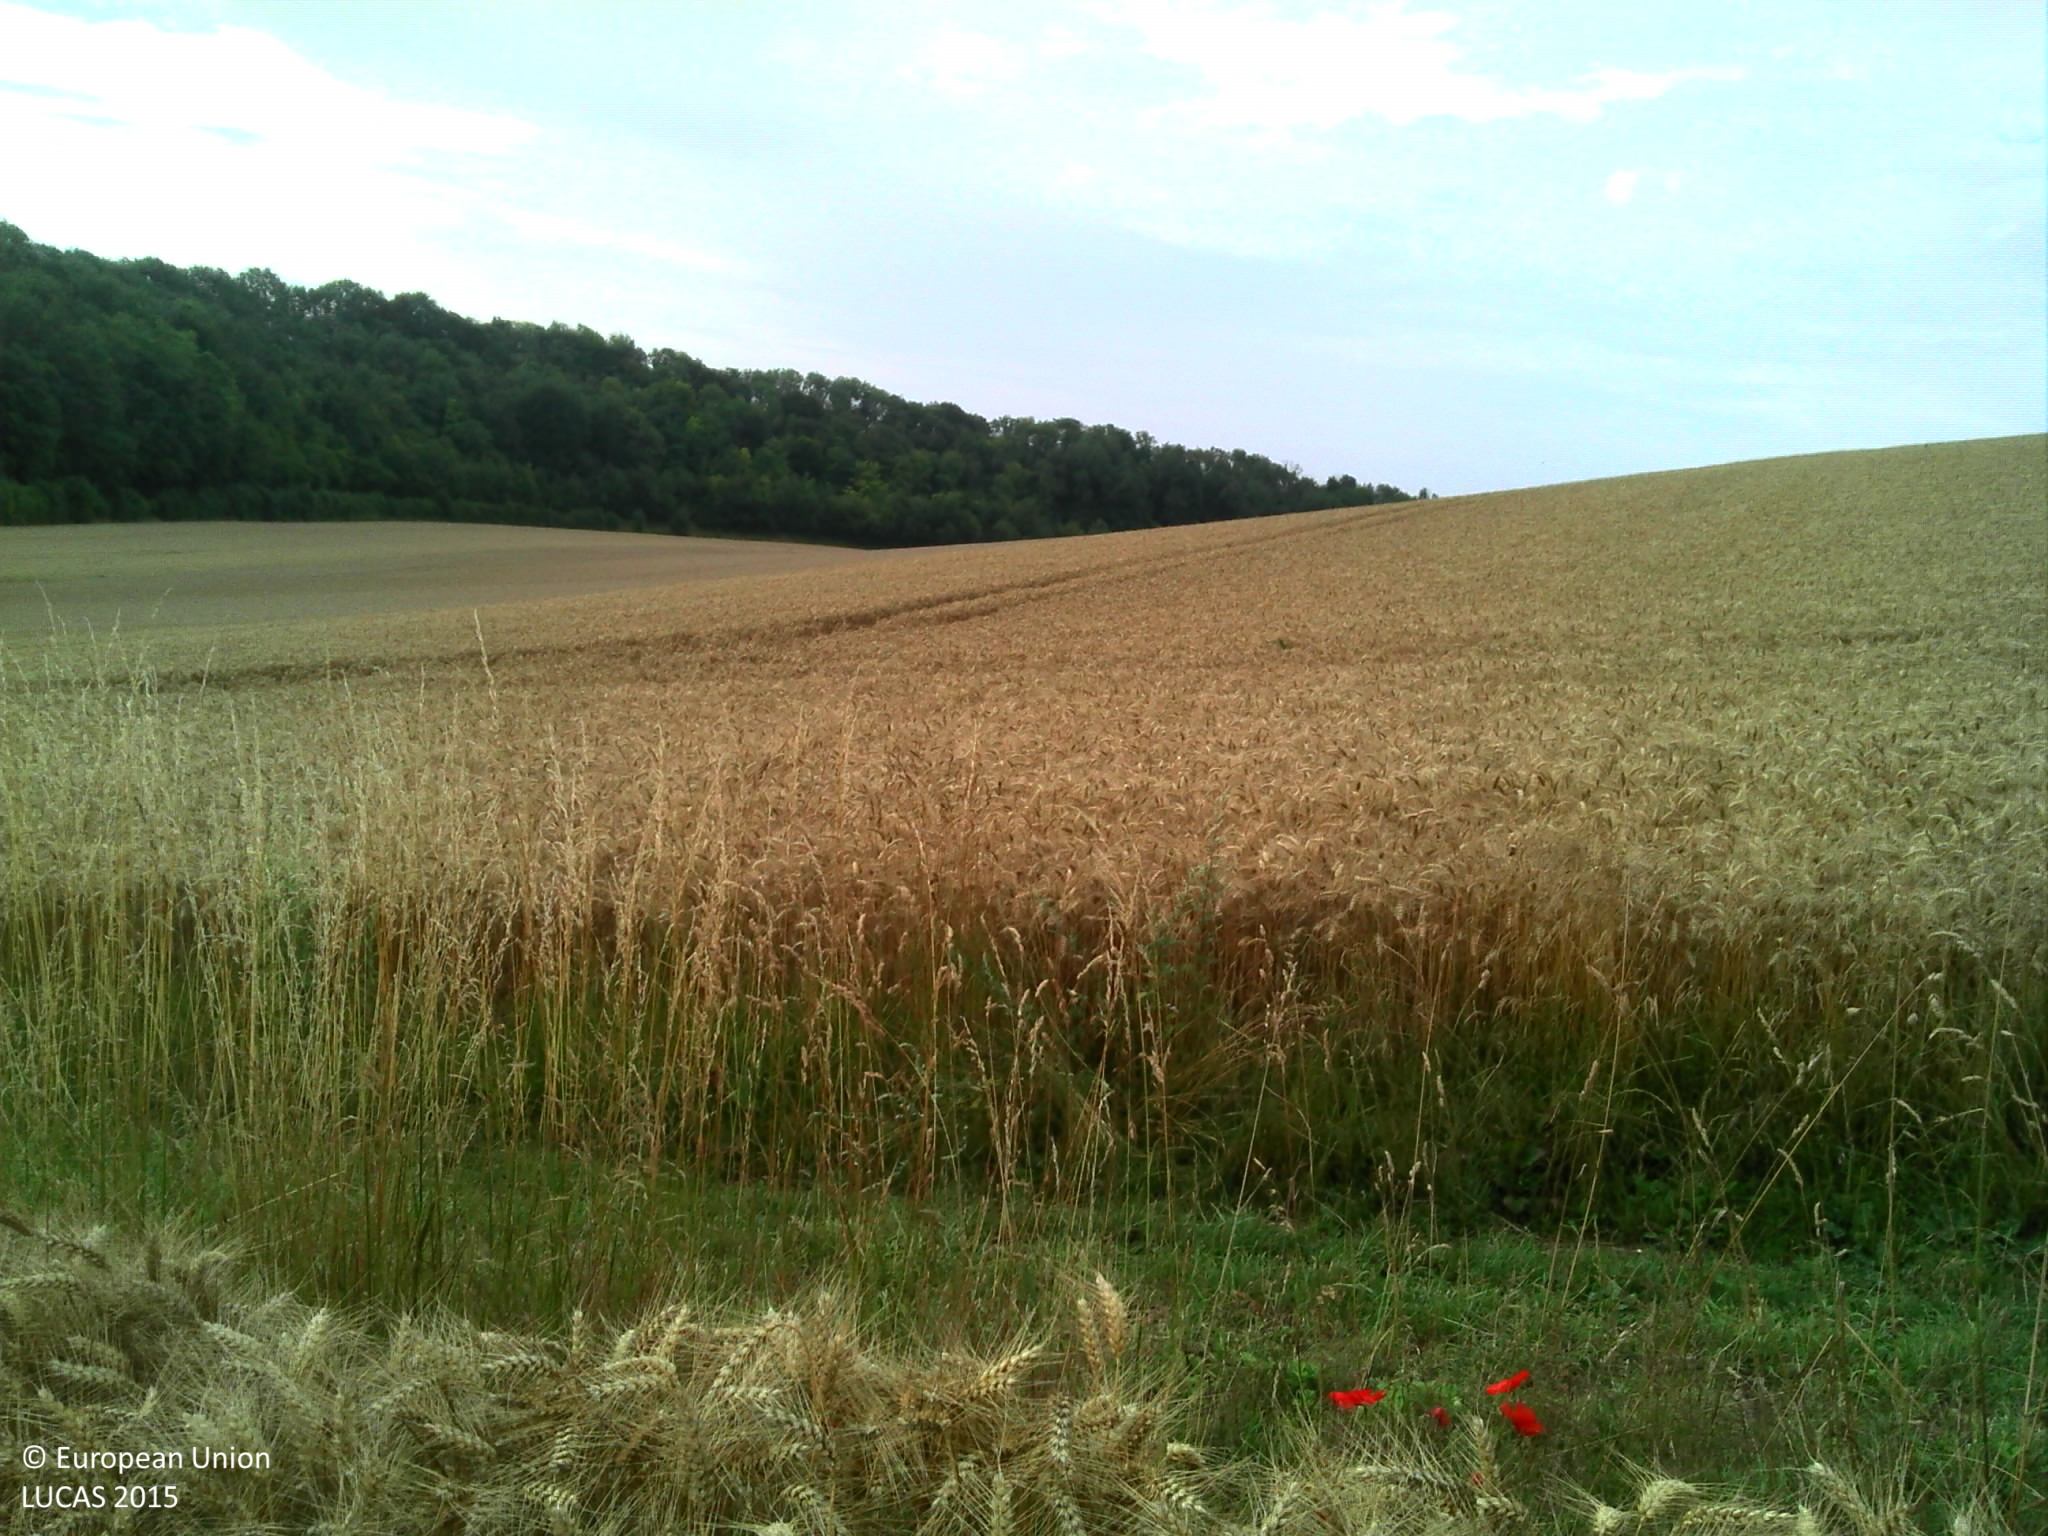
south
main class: Cropland
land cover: Durum wheat
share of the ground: > 75 %
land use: Agriculture (excluding fallow land and kitchen gardens)
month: July
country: FR
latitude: 50.0579
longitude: 2.1495
